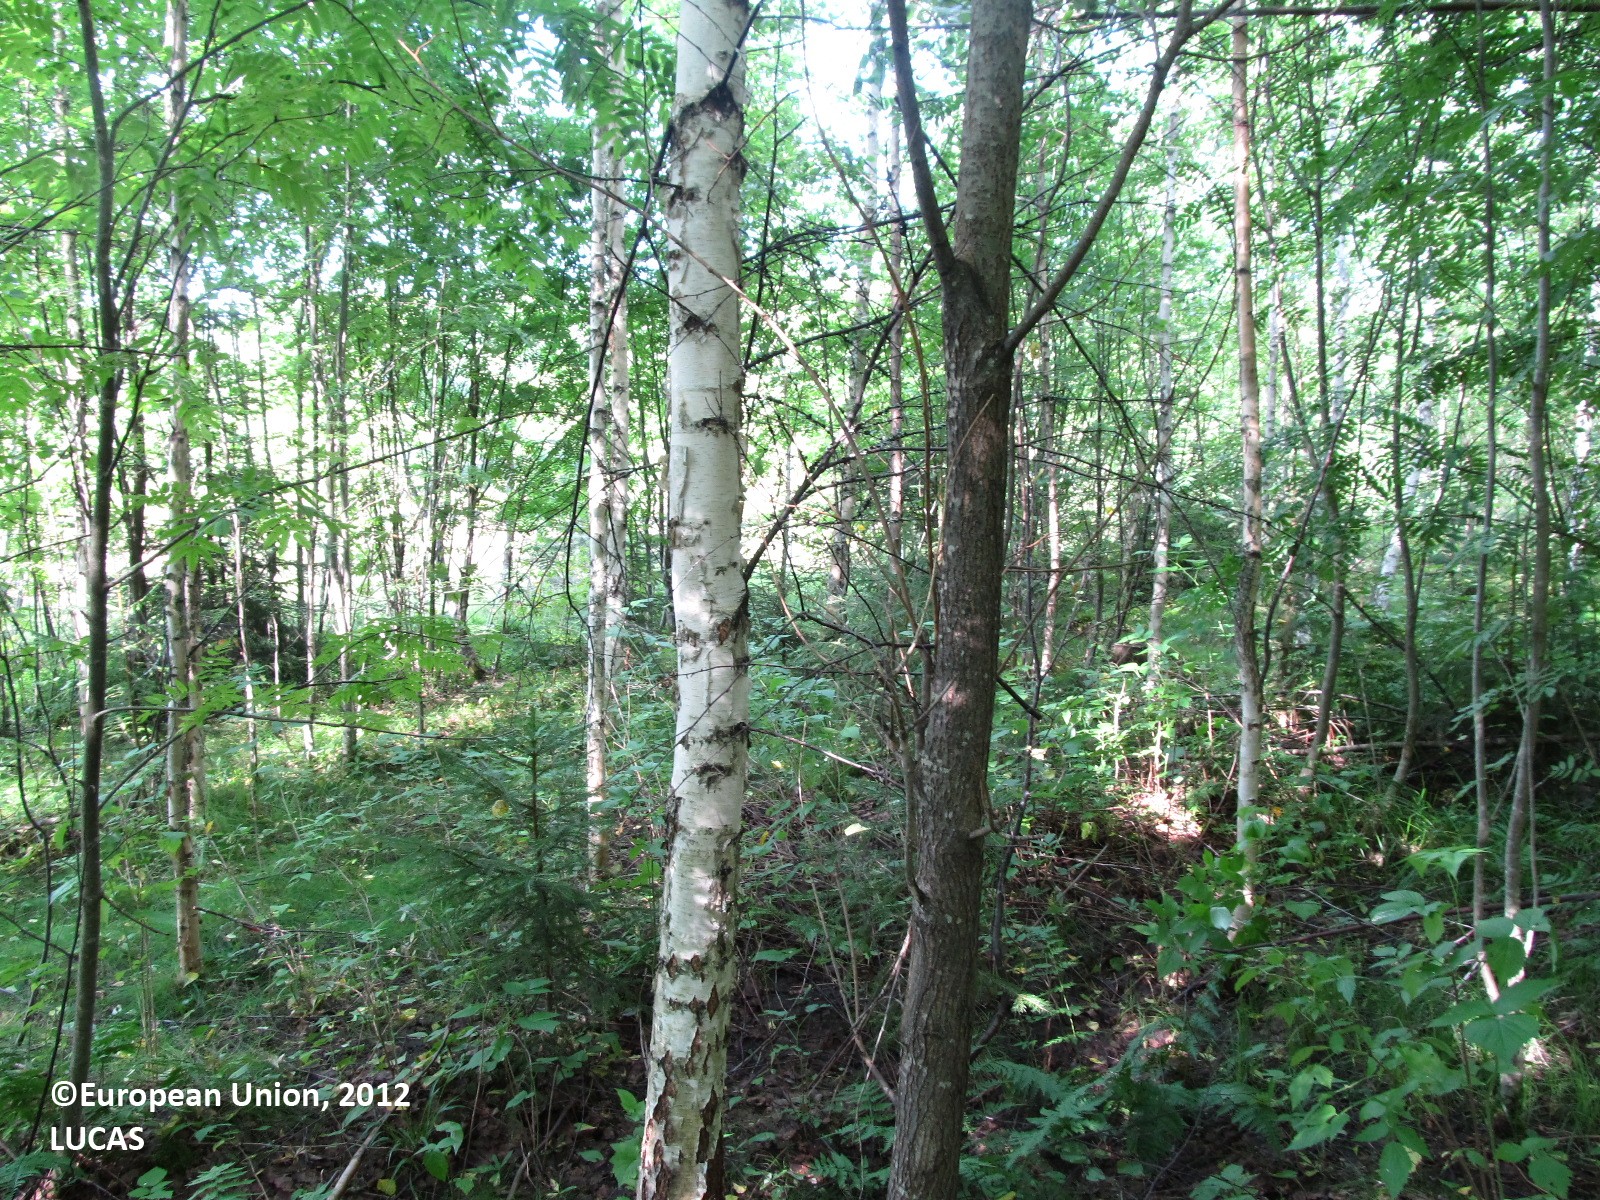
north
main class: Woodland
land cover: Broadleaved woodland
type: boreal forest
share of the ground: 25 - 50 %
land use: Forestry
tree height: > 5 m
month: July
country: FI
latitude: 62.0558
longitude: 28.1162
